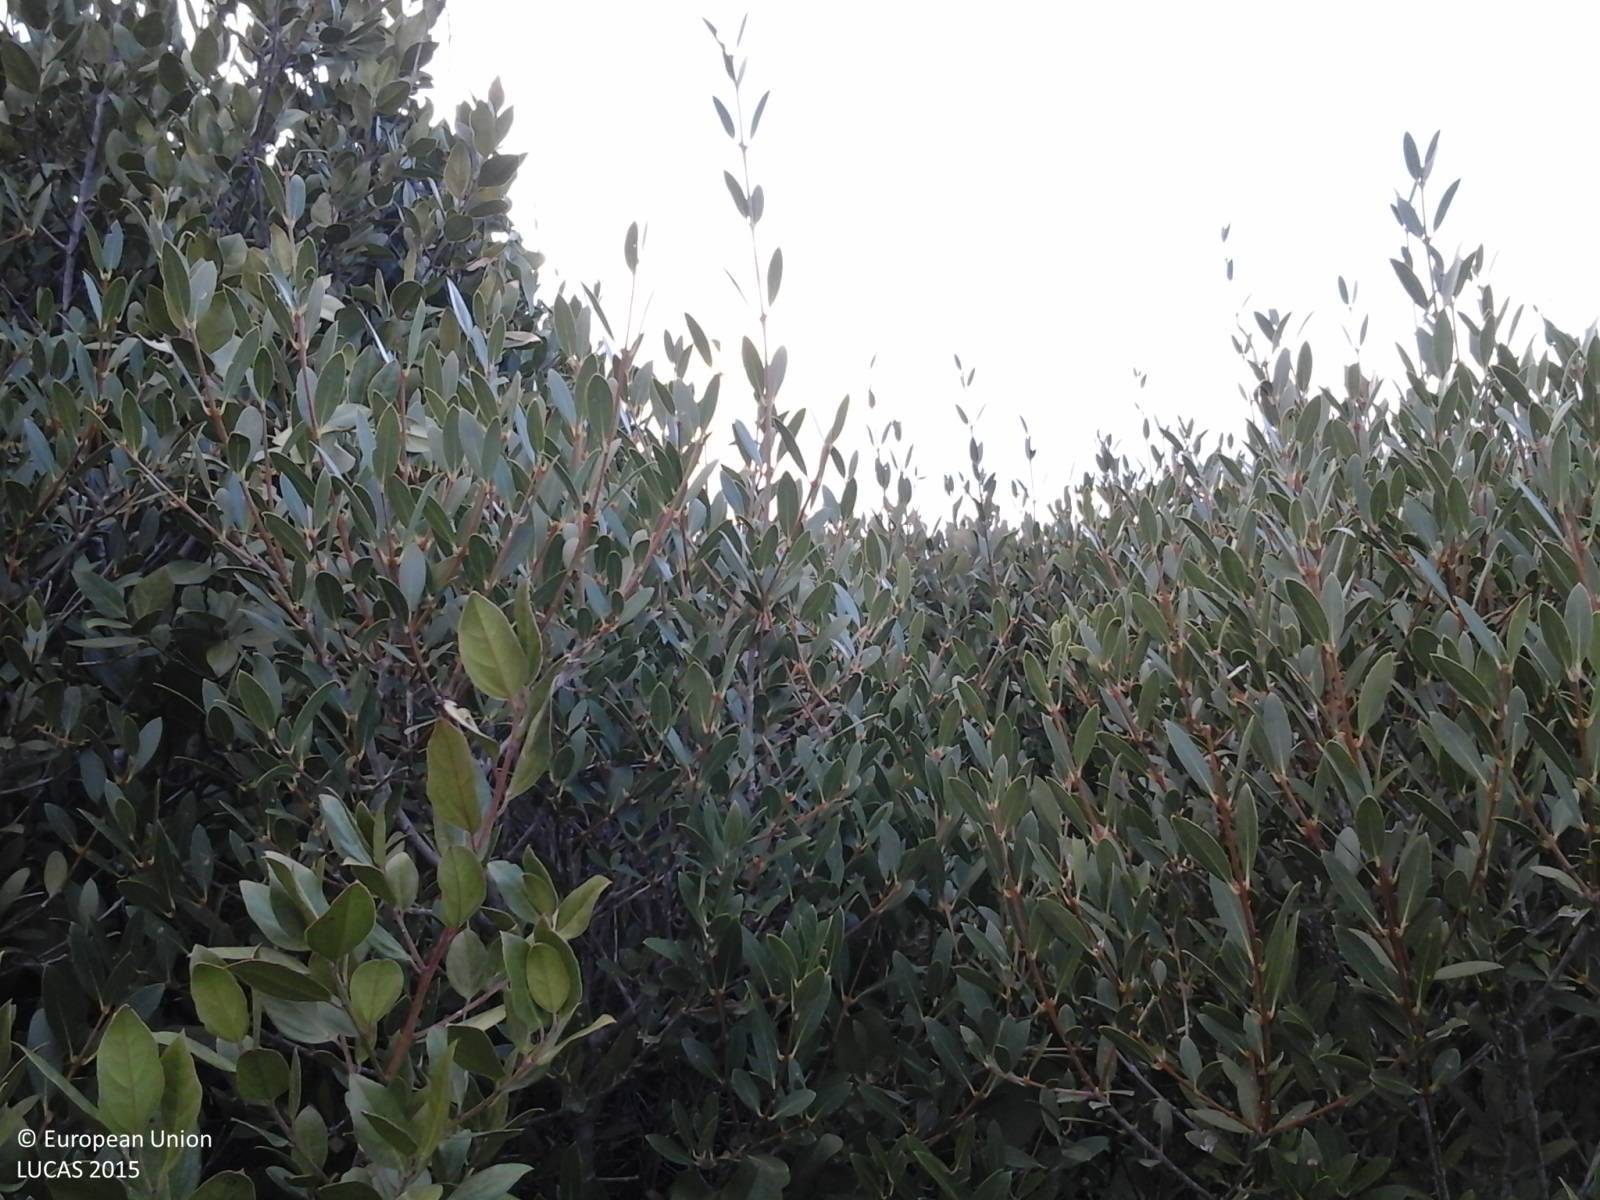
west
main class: Shrubland
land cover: Shrubland without tree cover
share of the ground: > 75 %
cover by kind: shrubs 100 %
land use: Semi-natural and natural areas not in use
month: September
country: IT
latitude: 43.0319
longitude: 10.5261
